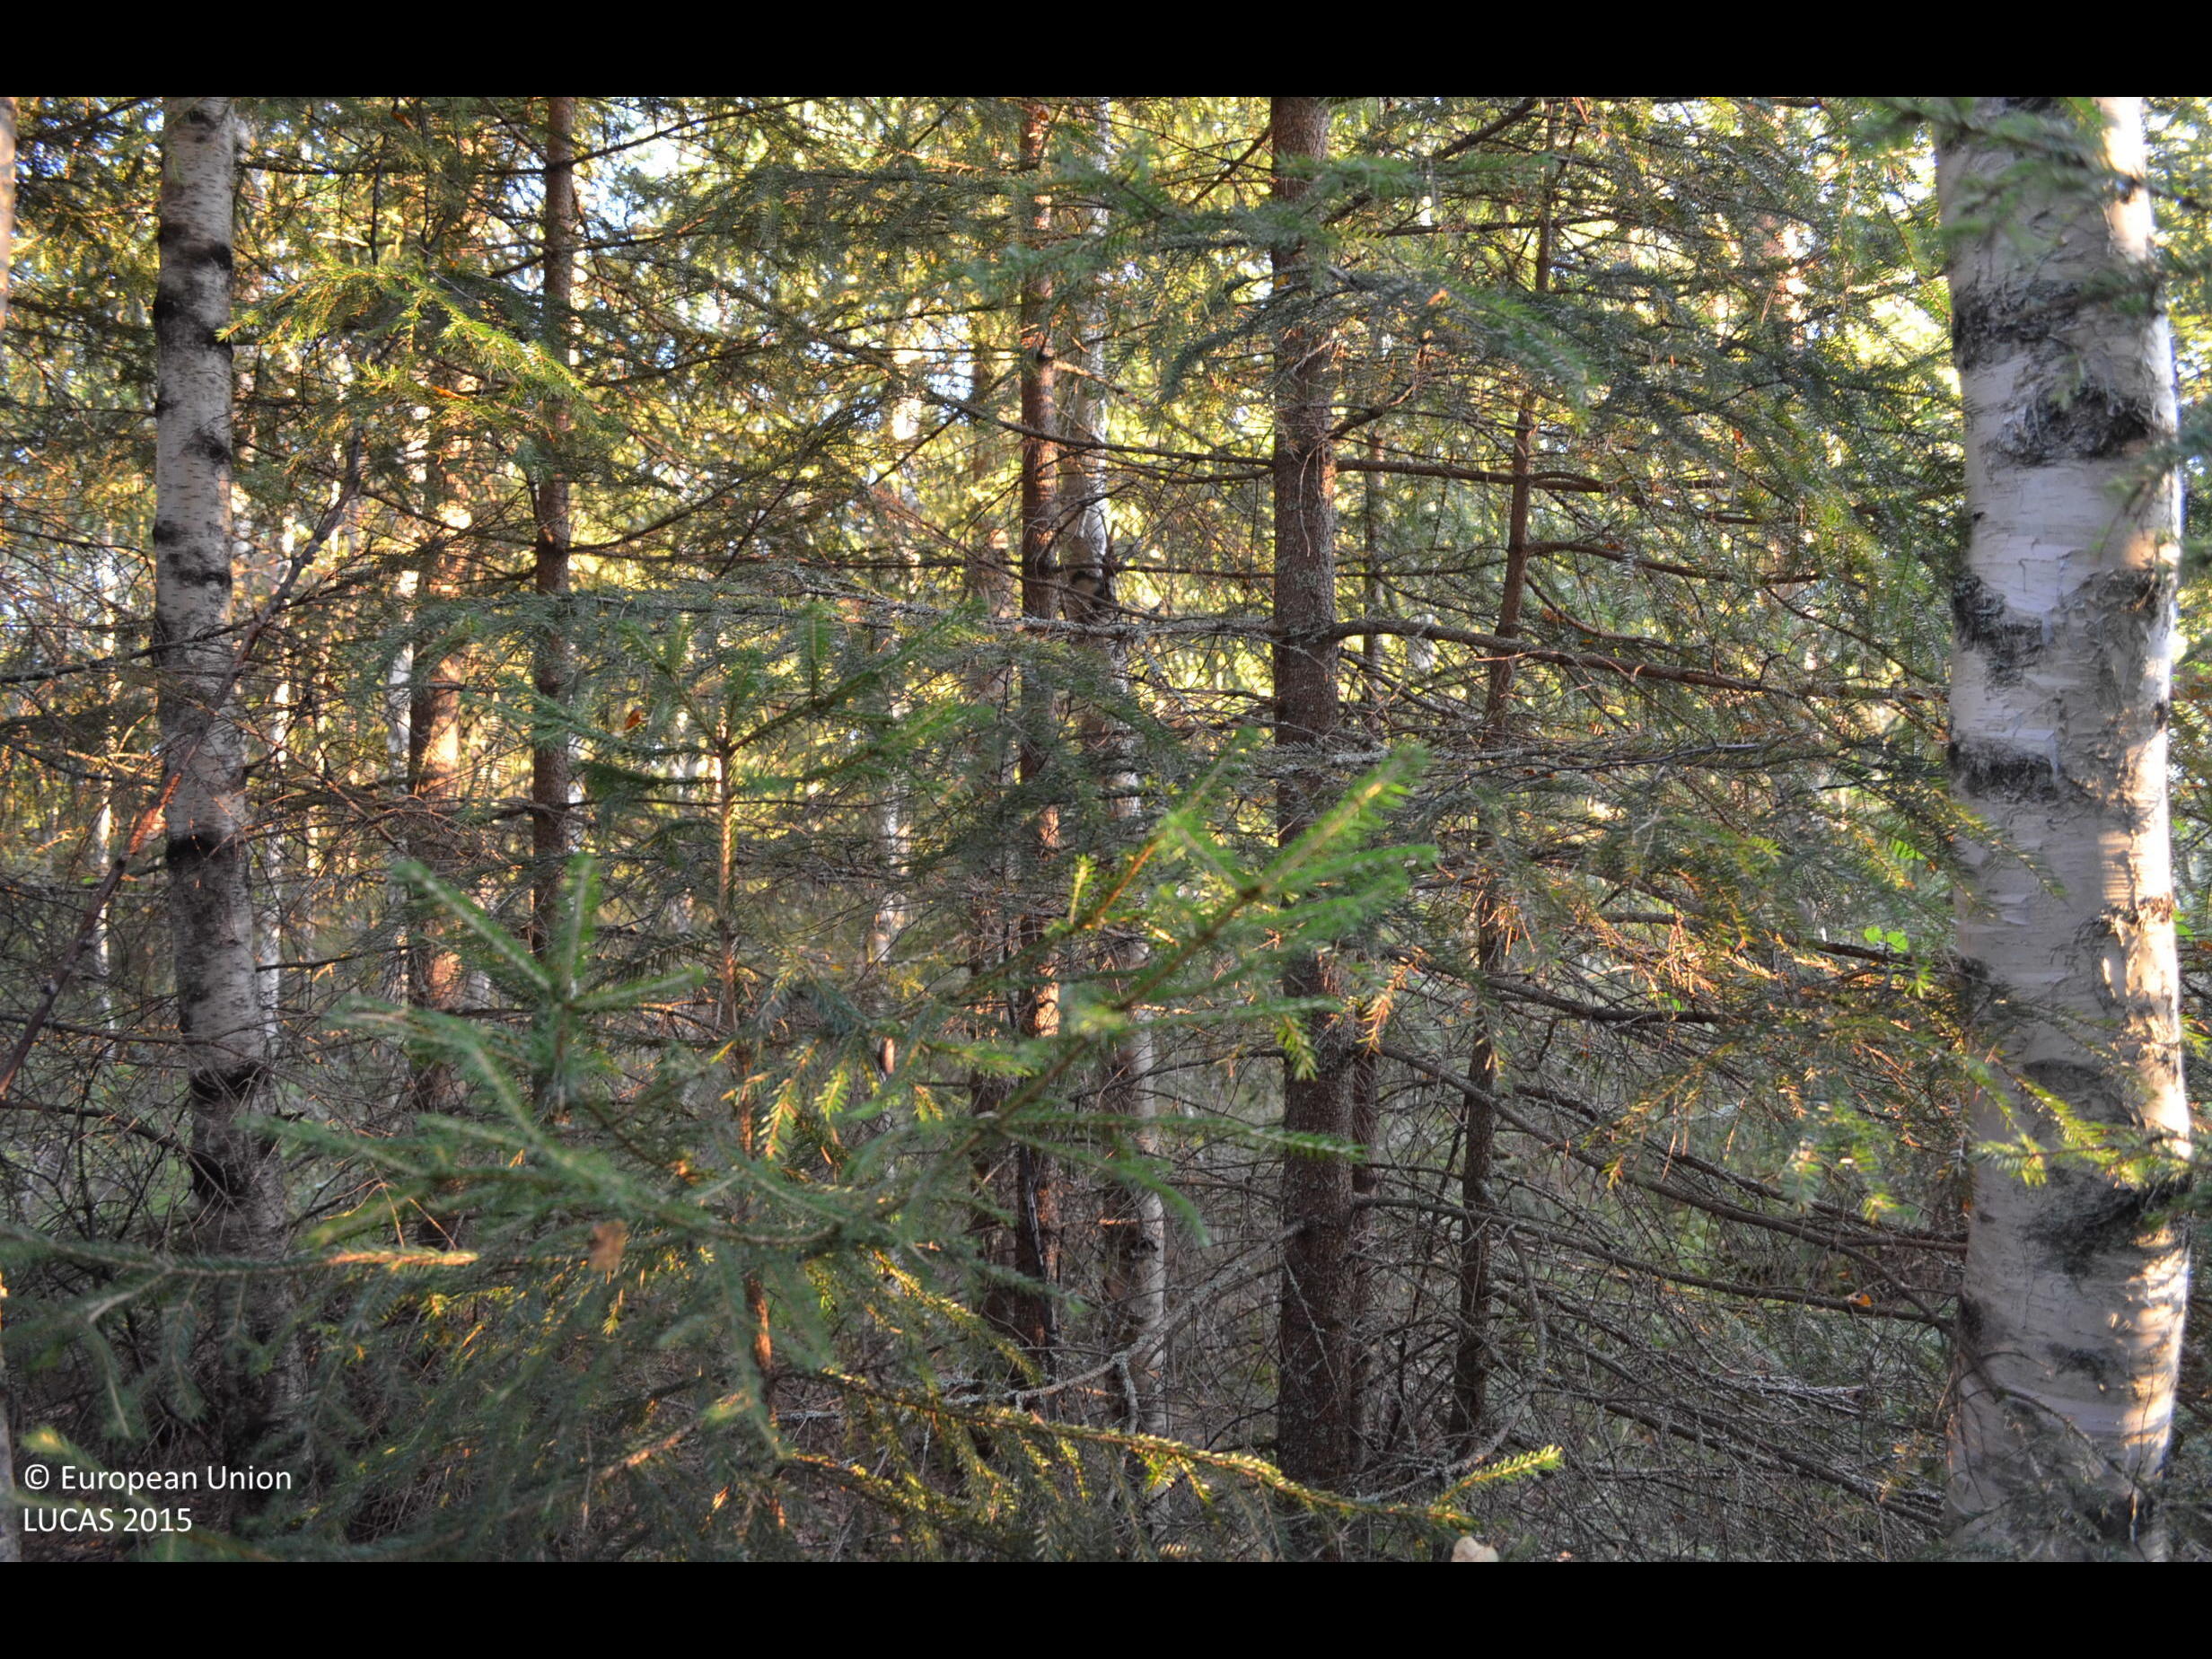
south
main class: Woodland
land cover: Other mixed woodland
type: boreal forest
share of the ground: > 75 %
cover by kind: coniferous forest trees 45 %, broadleaved forest trees 40 %, shrubs 5 %, herbaceous plants 5 %
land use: Forestry
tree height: > 5 m
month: August
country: FI
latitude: 62.4965
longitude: 24.4722
